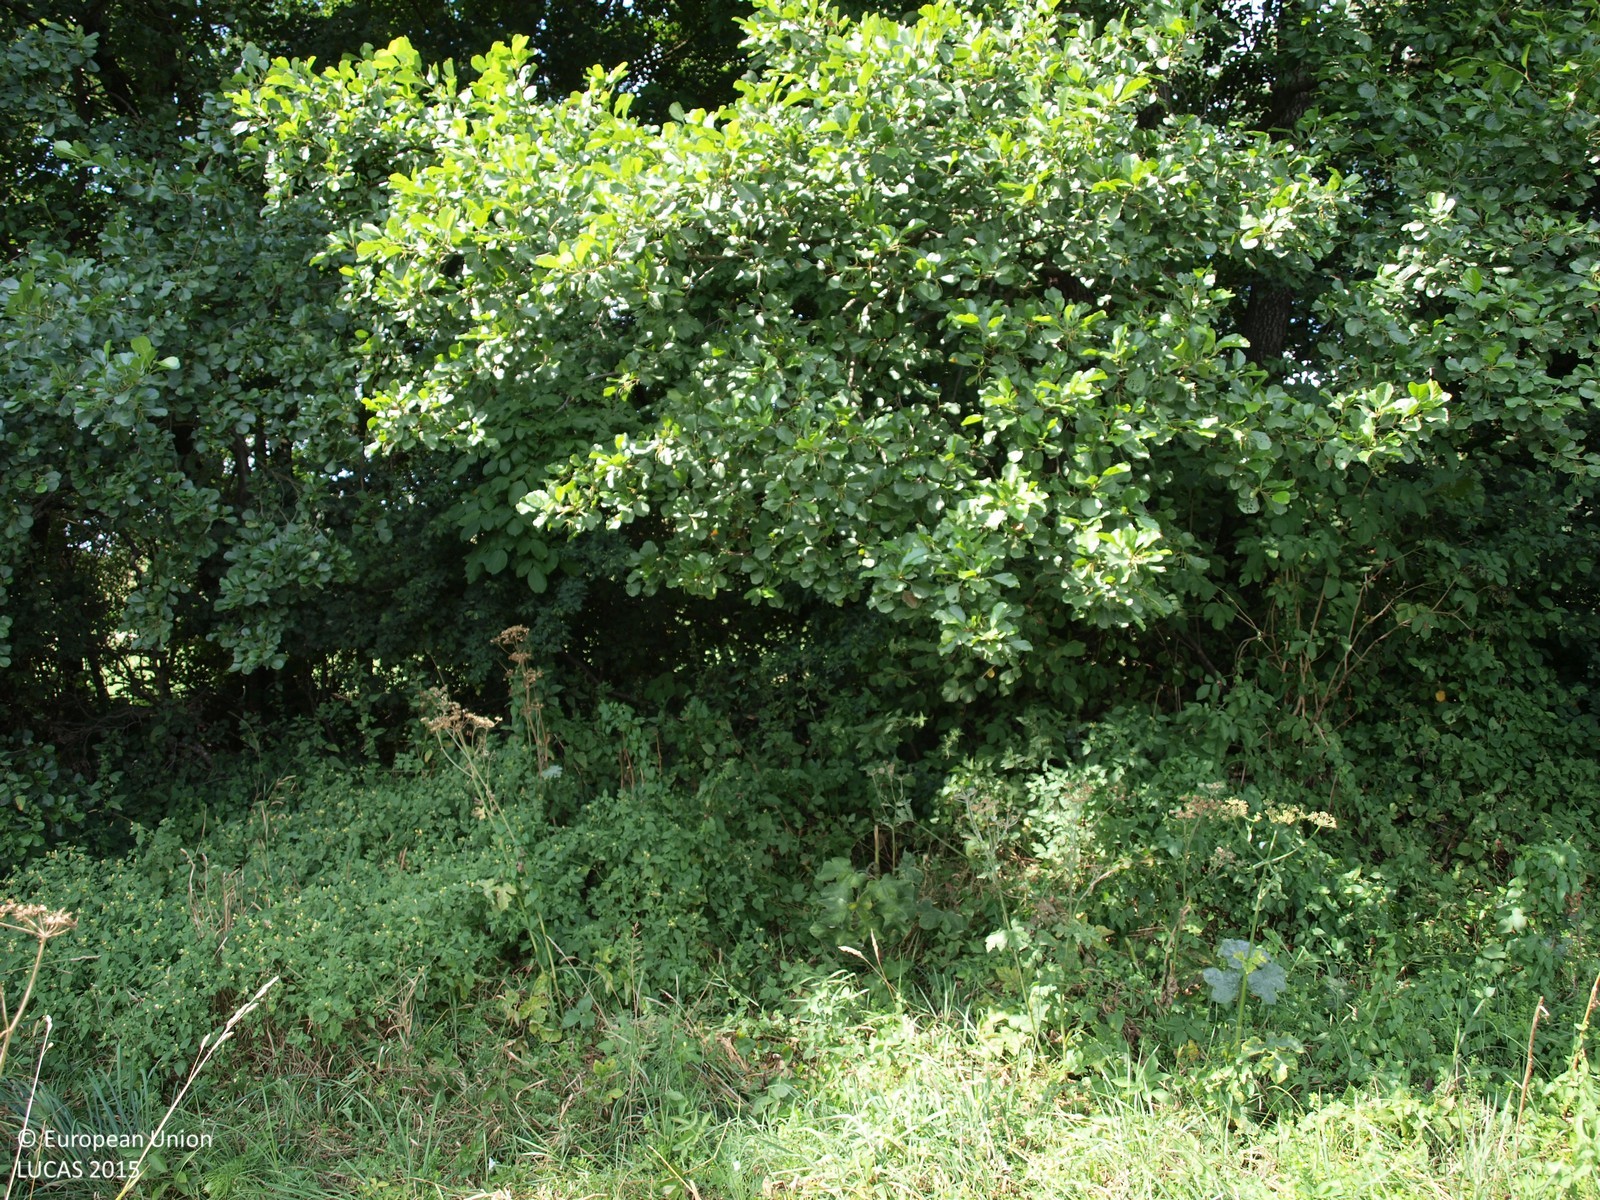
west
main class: Grassland
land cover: Grassland without tree/shrub cover
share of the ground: > 75 %
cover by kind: herbaceous plants 100 %
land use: Agriculture (excluding fallow land and kitchen gardens)
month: August
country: HR
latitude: 46.1168
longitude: 16.5087
